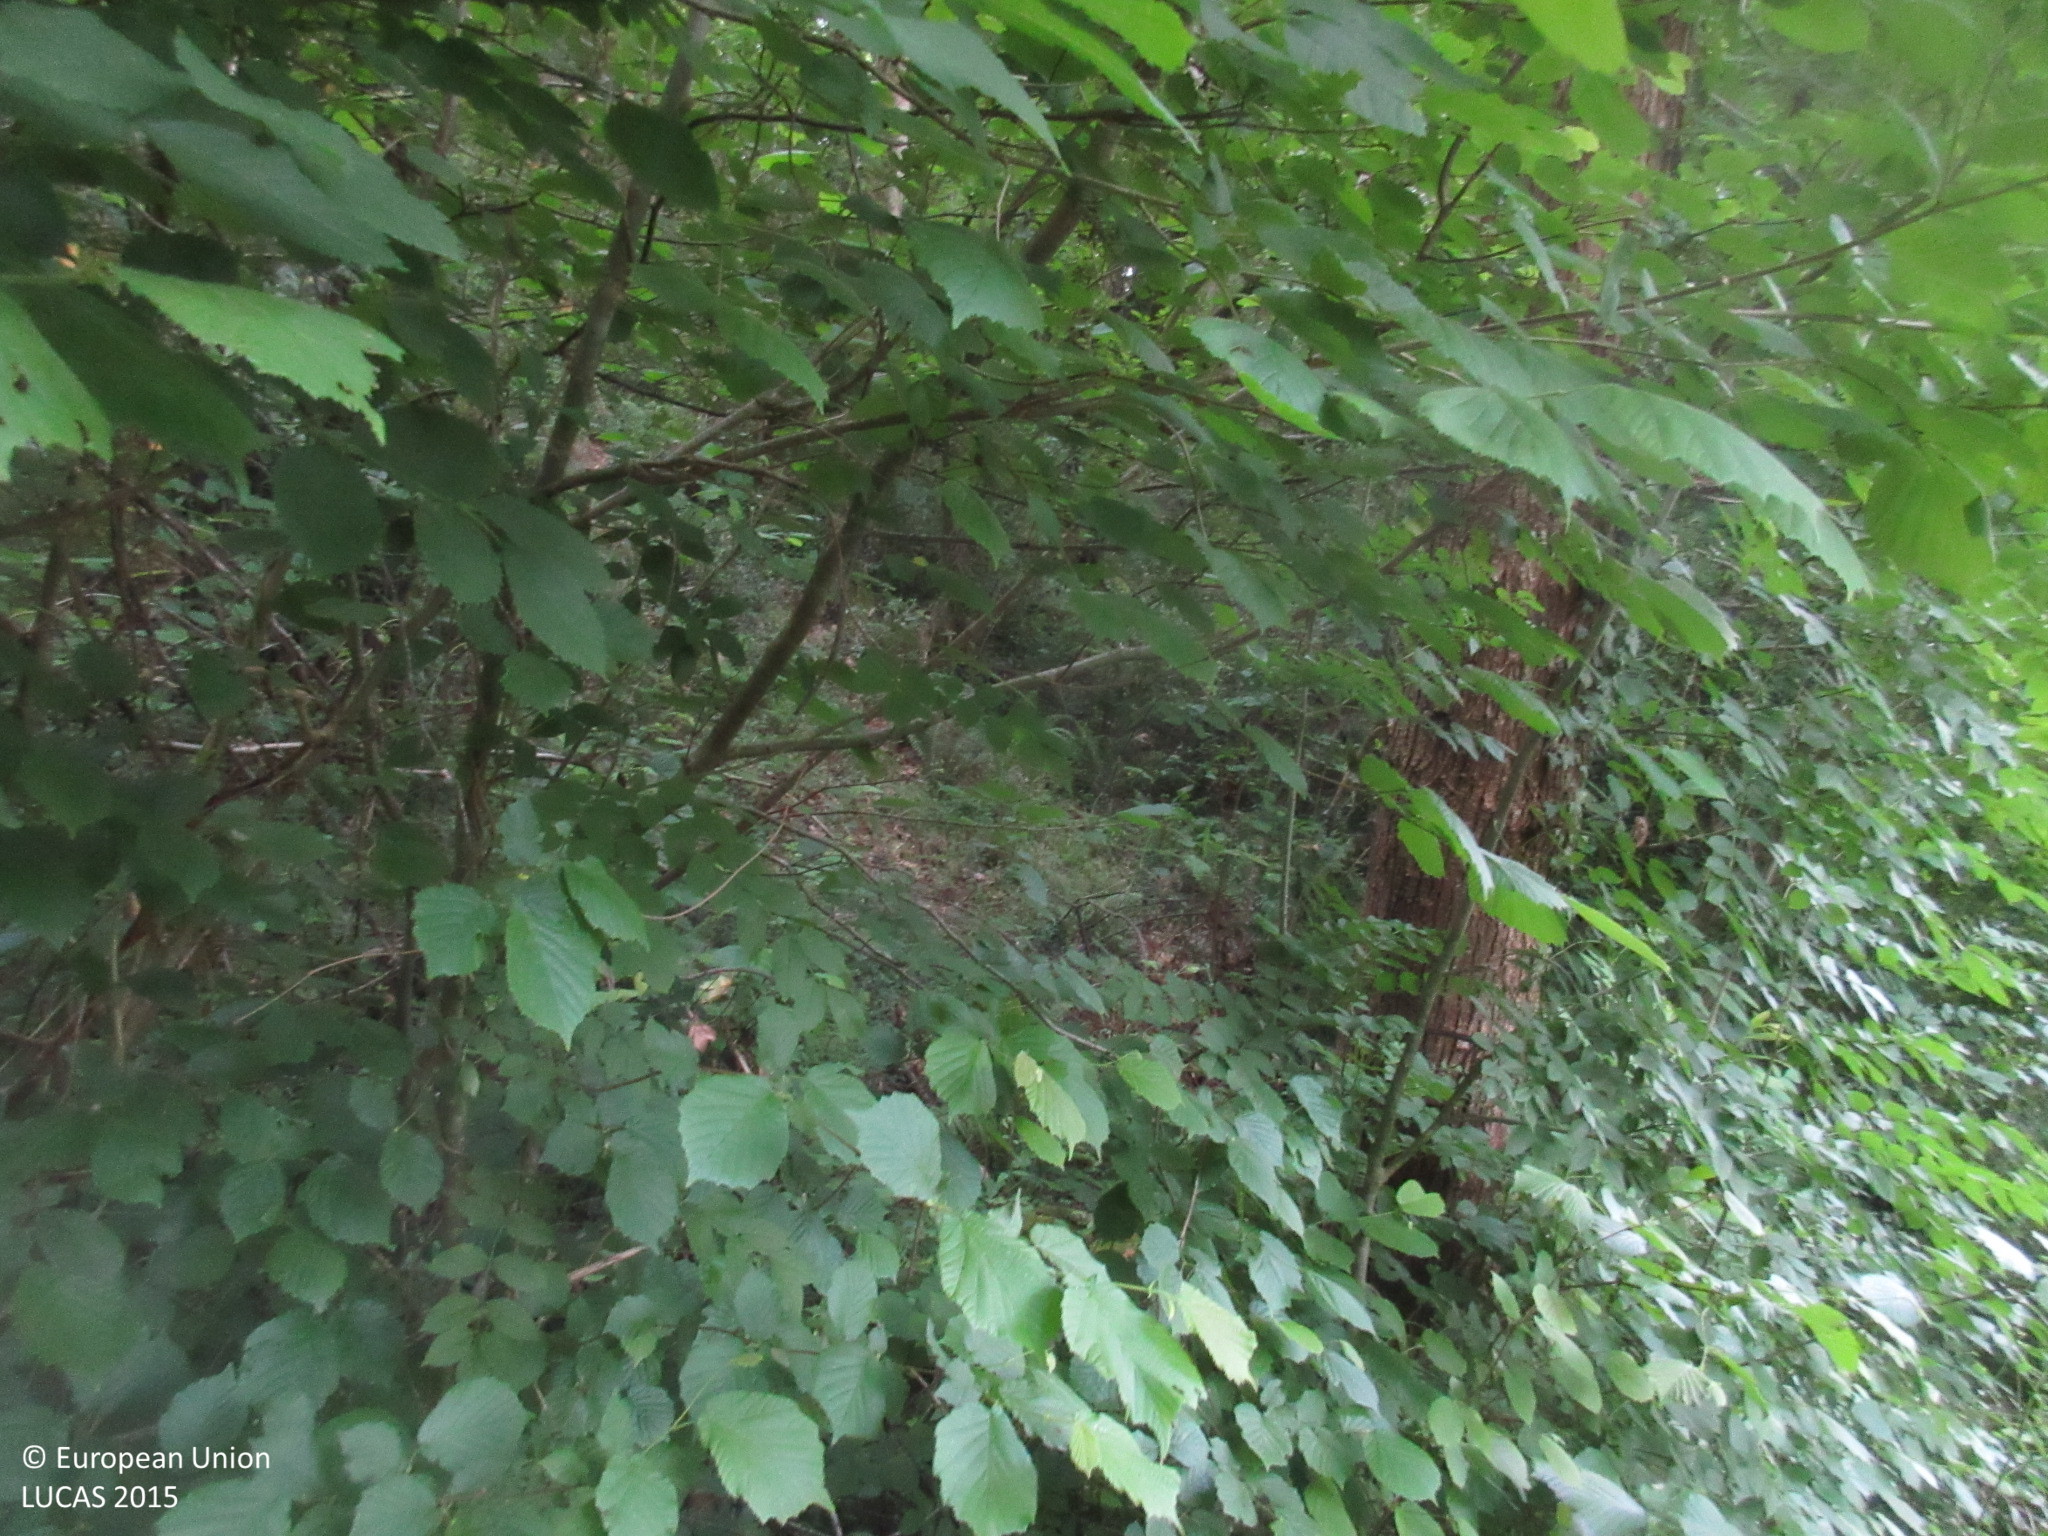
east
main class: Woodland
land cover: Broadleaved woodland
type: thermophilous deciduous forest
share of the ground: > 75 %
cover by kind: broadleaved forest trees 100 %
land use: Forestry
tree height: > 5 m
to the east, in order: Broadleaved woodland; Grassland without tree/shrub cover
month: June
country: ES
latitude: 43.2892
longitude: -3.4386
